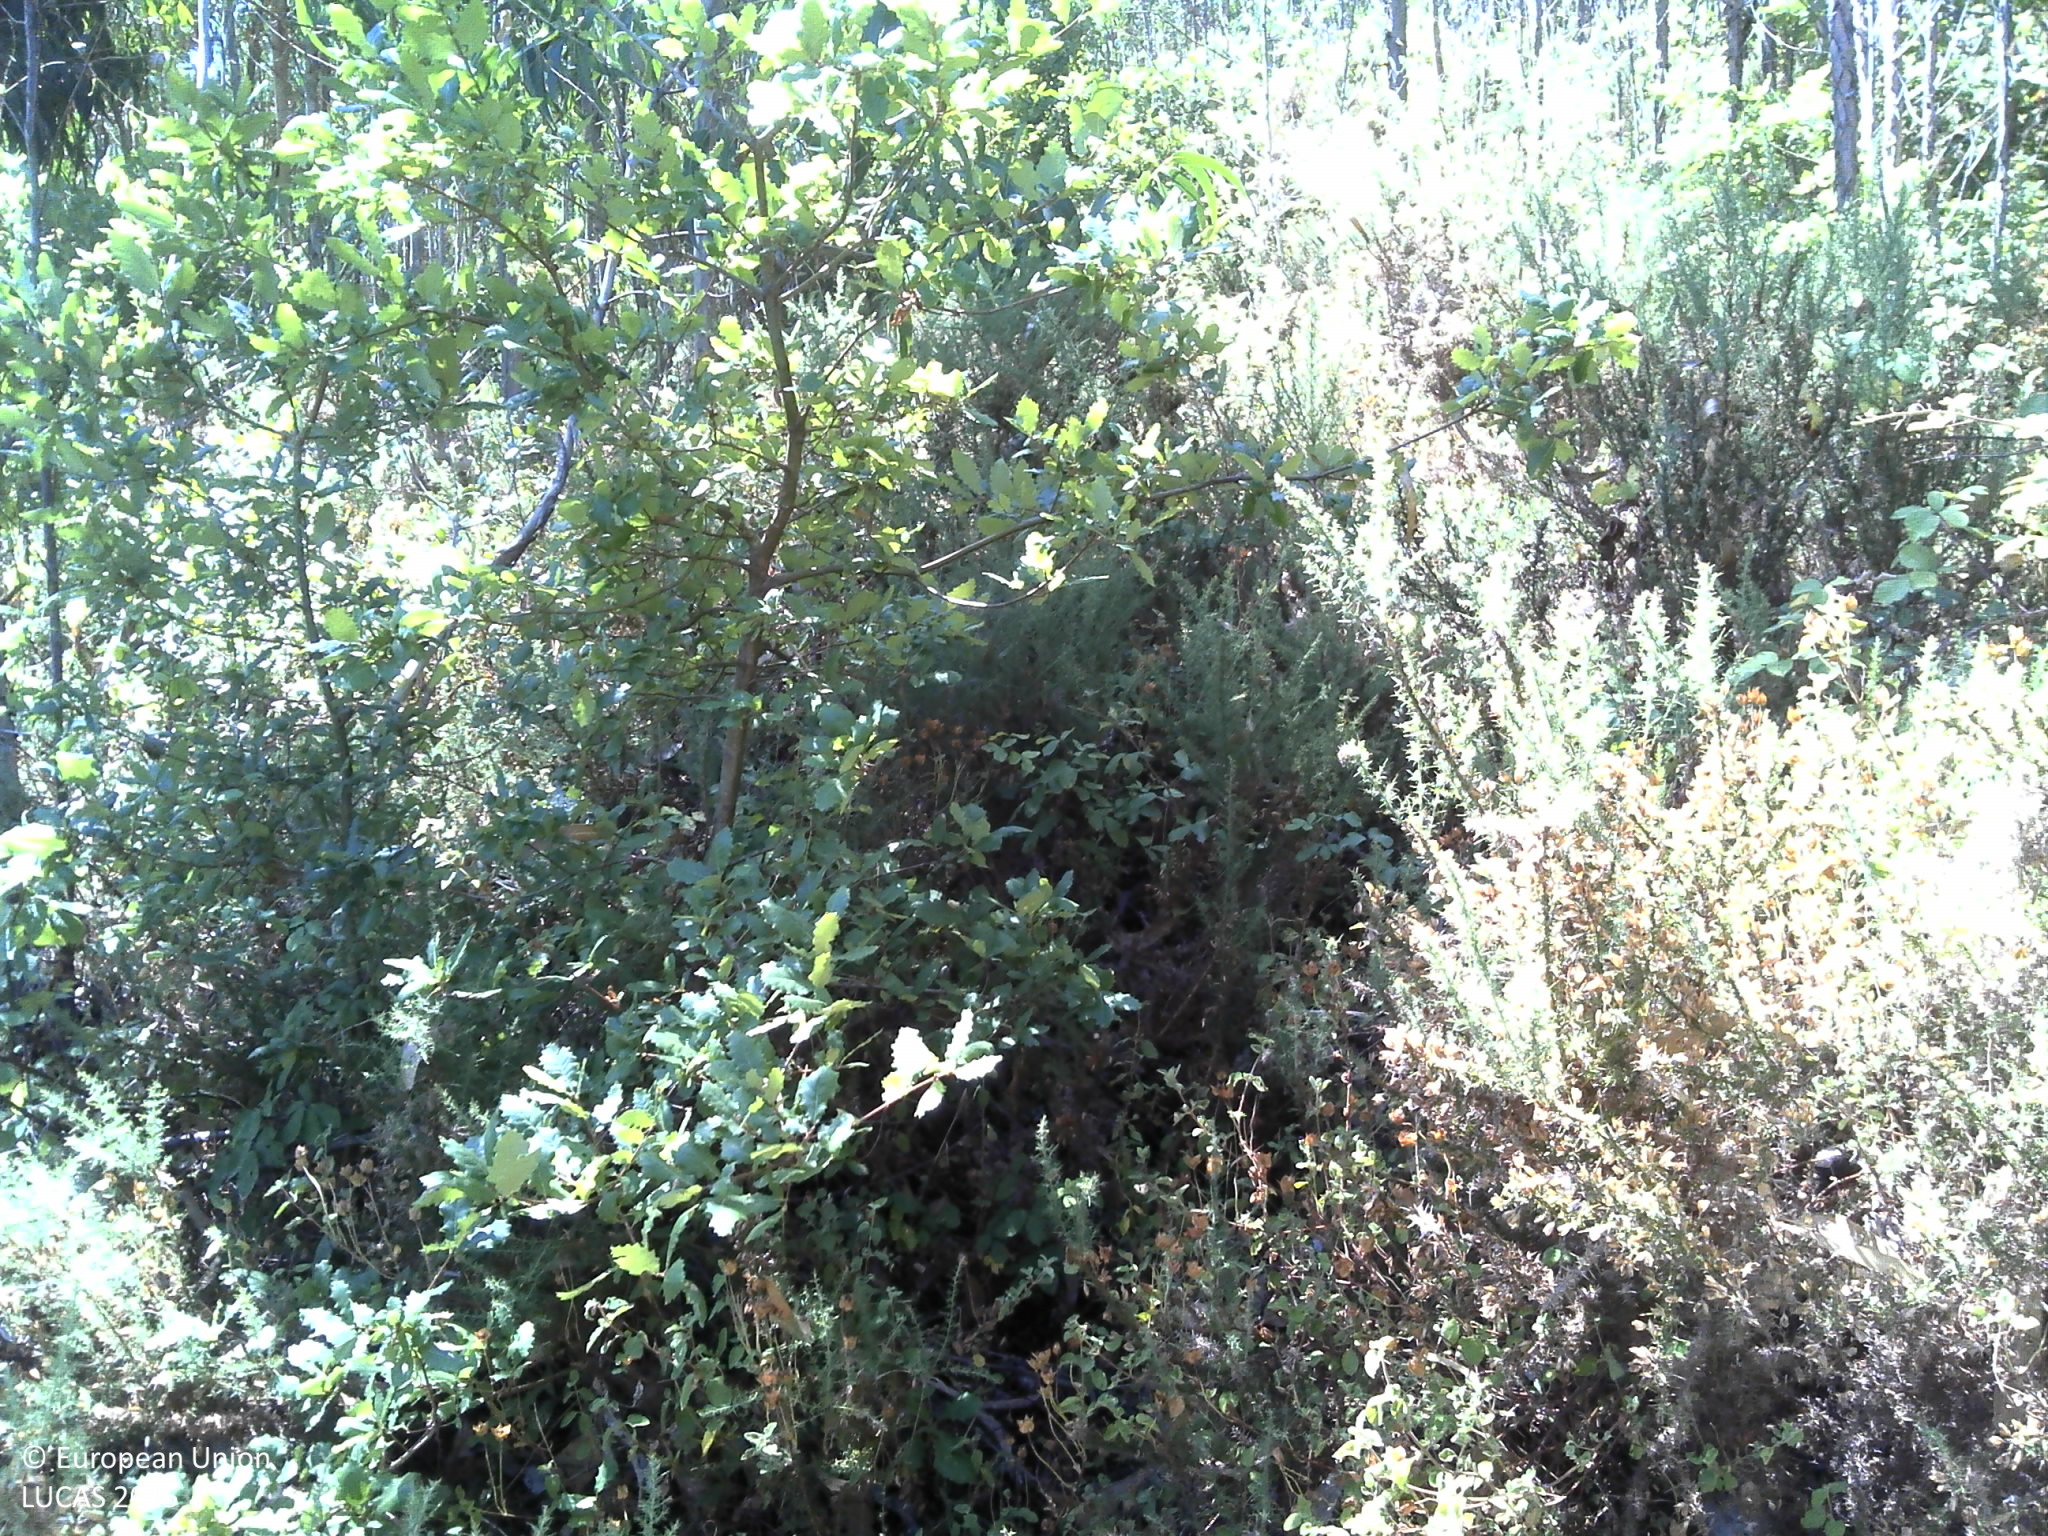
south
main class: Woodland
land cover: Broadleaved woodland
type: exotic forest
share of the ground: 50 - 75 %
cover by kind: broadleaved forest trees 55 %, shrubs 30 %, unconsolidated bare surface 15 %
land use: Forestry
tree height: > 5 m
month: July
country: PT
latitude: 38.9524
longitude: -9.2494
